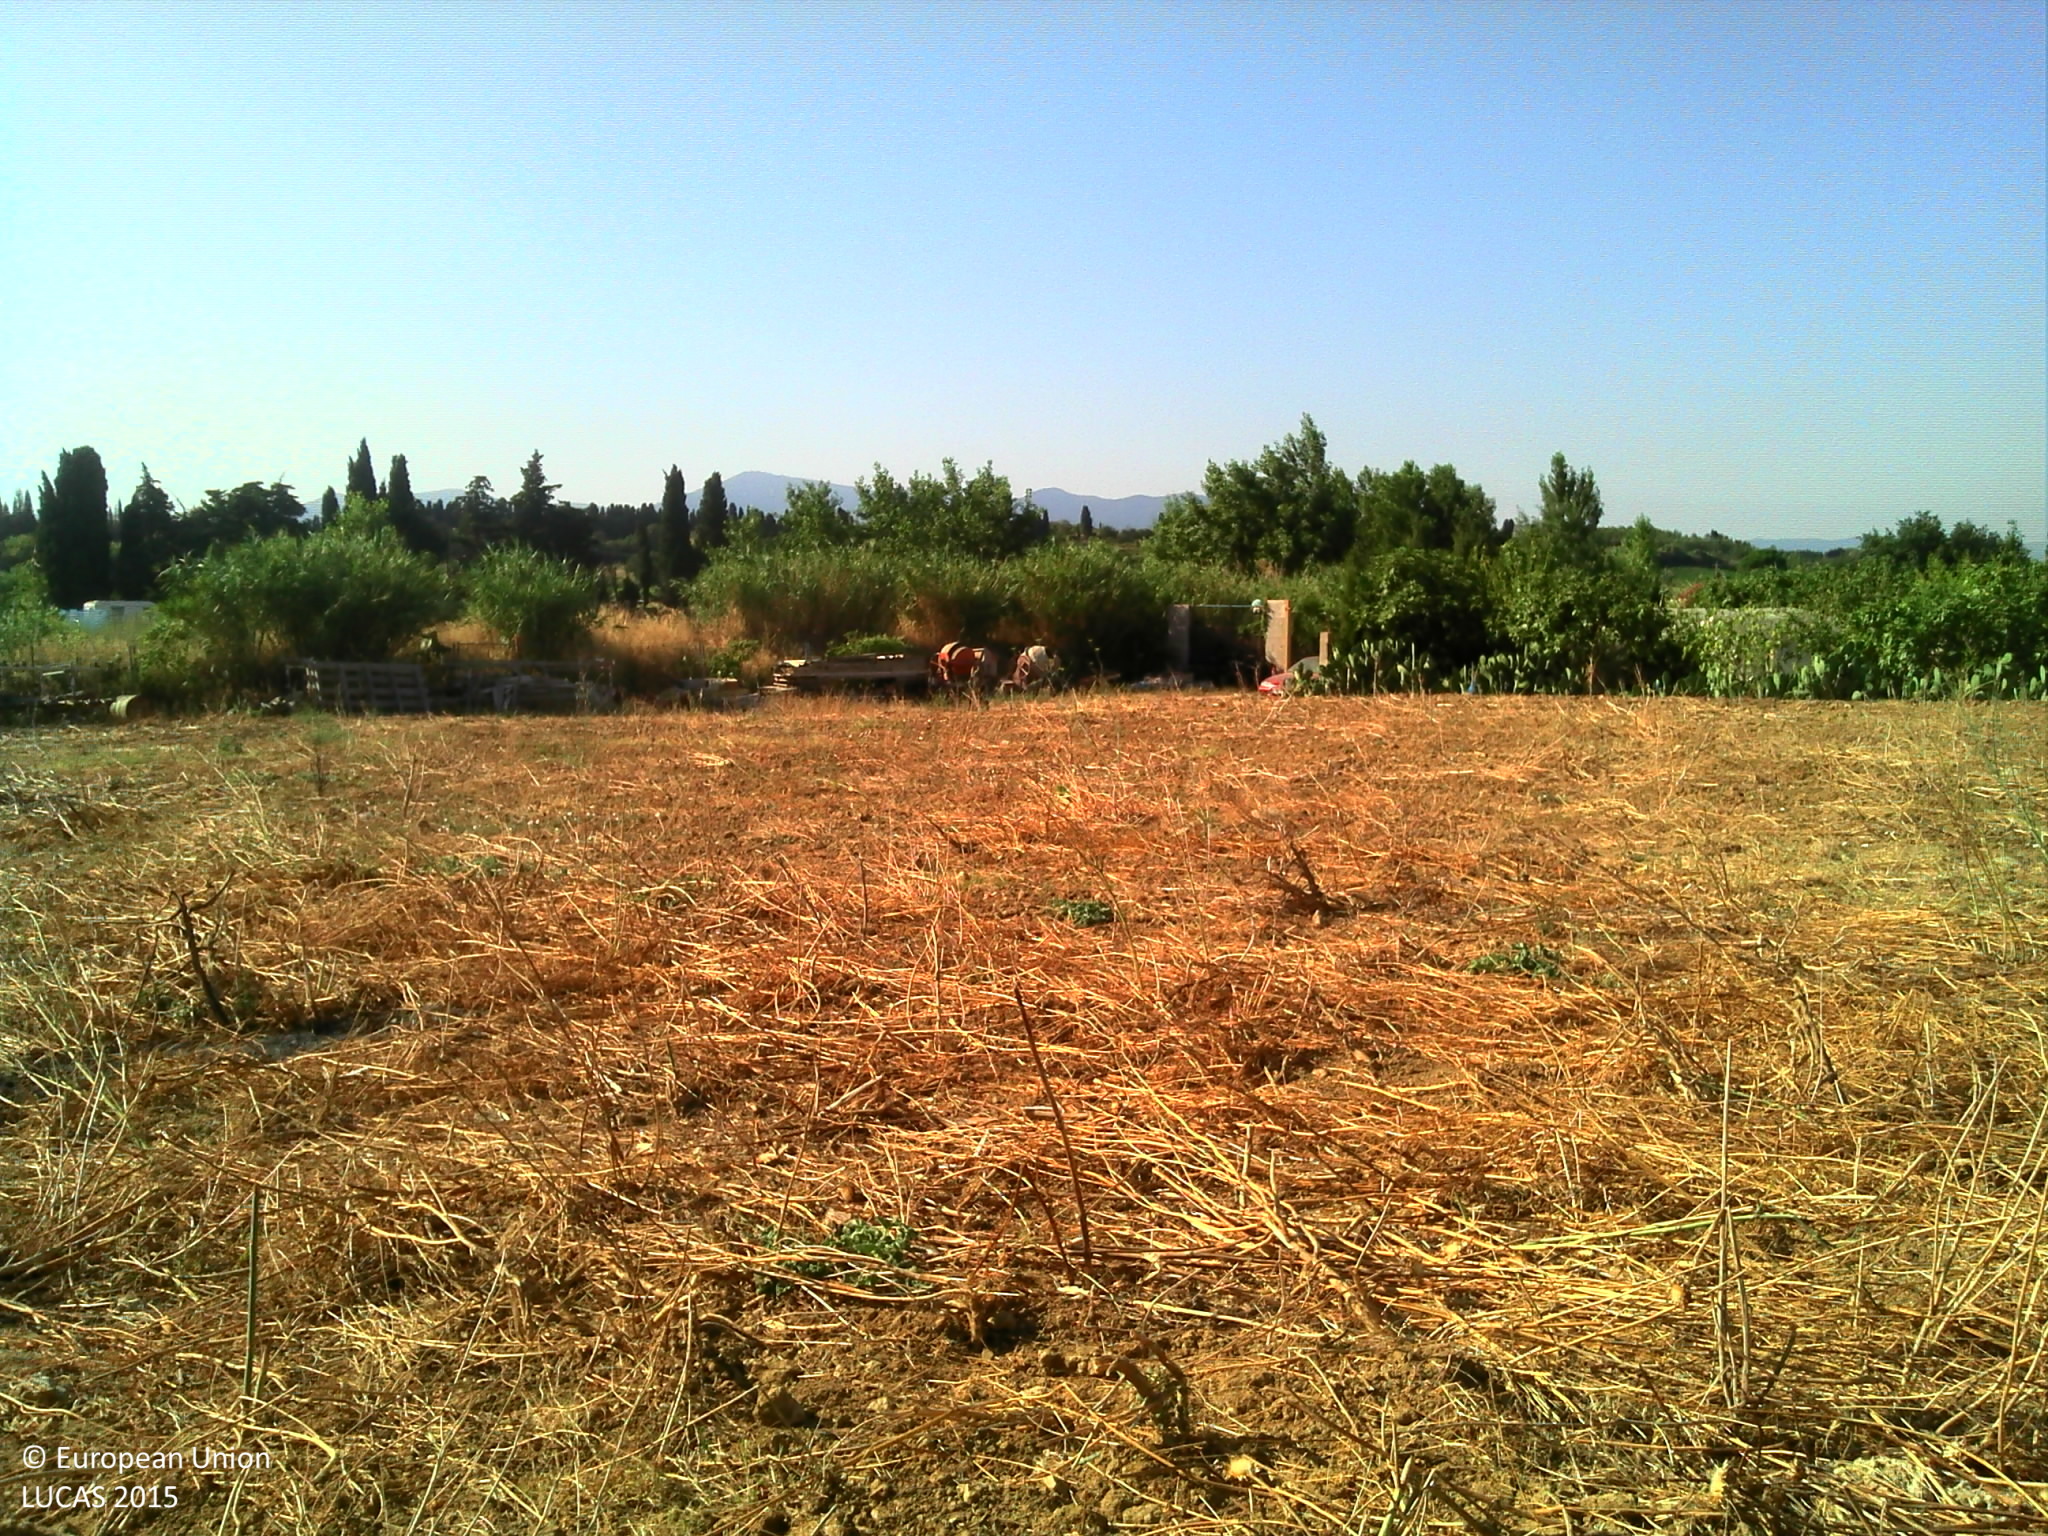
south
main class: Woodland
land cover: Broadleaved woodland
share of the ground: > 75 %
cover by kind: herbaceous plants 50 %, unconsolidated bare surface 25 %, broadleaved forest trees 20 %, shrubs 5 %
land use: Agriculture (excluding fallow land and kitchen gardens)
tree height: < 5 m
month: July
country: FR
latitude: 42.6387
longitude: 2.8778
